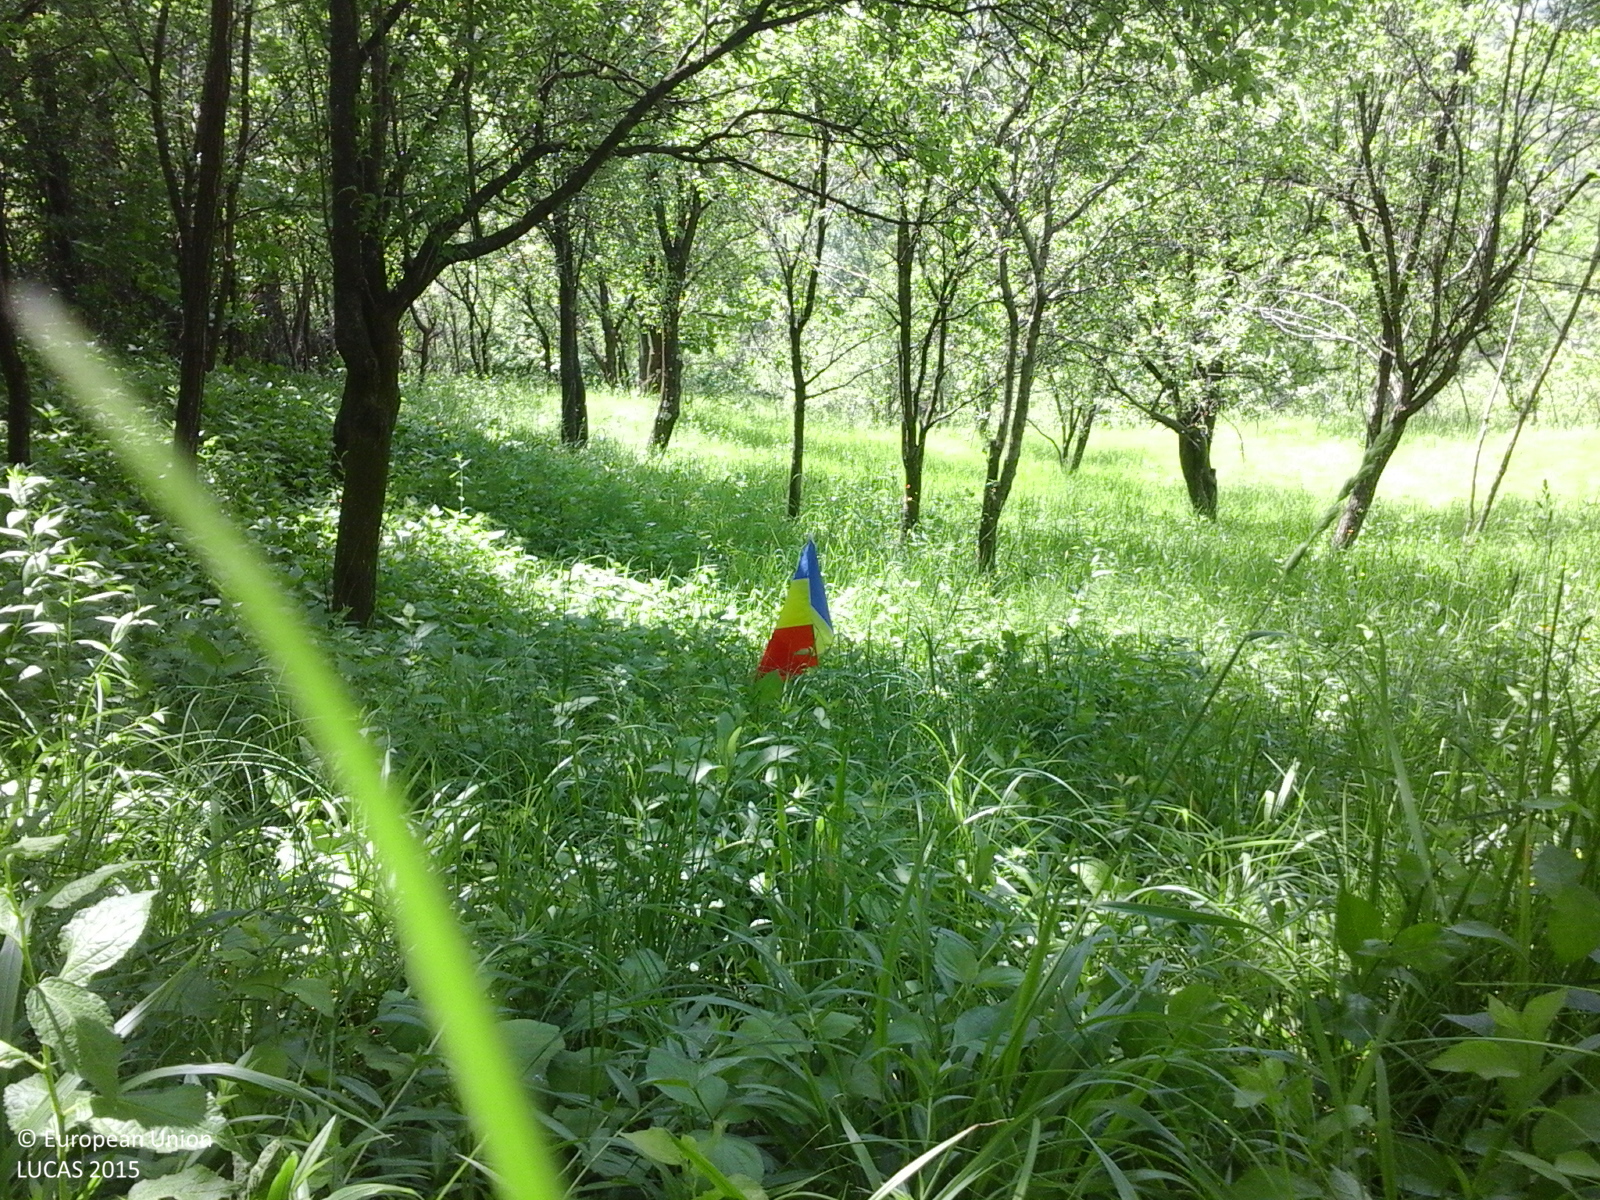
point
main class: Cropland
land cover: Other fruit trees and berries
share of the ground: 50 - 75 %
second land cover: Grassland without tree/shrub cover
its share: > 75 %
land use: Agriculture (excluding fallow land and kitchen gardens)
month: May
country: RO
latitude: 45.1500
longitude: 26.1521
